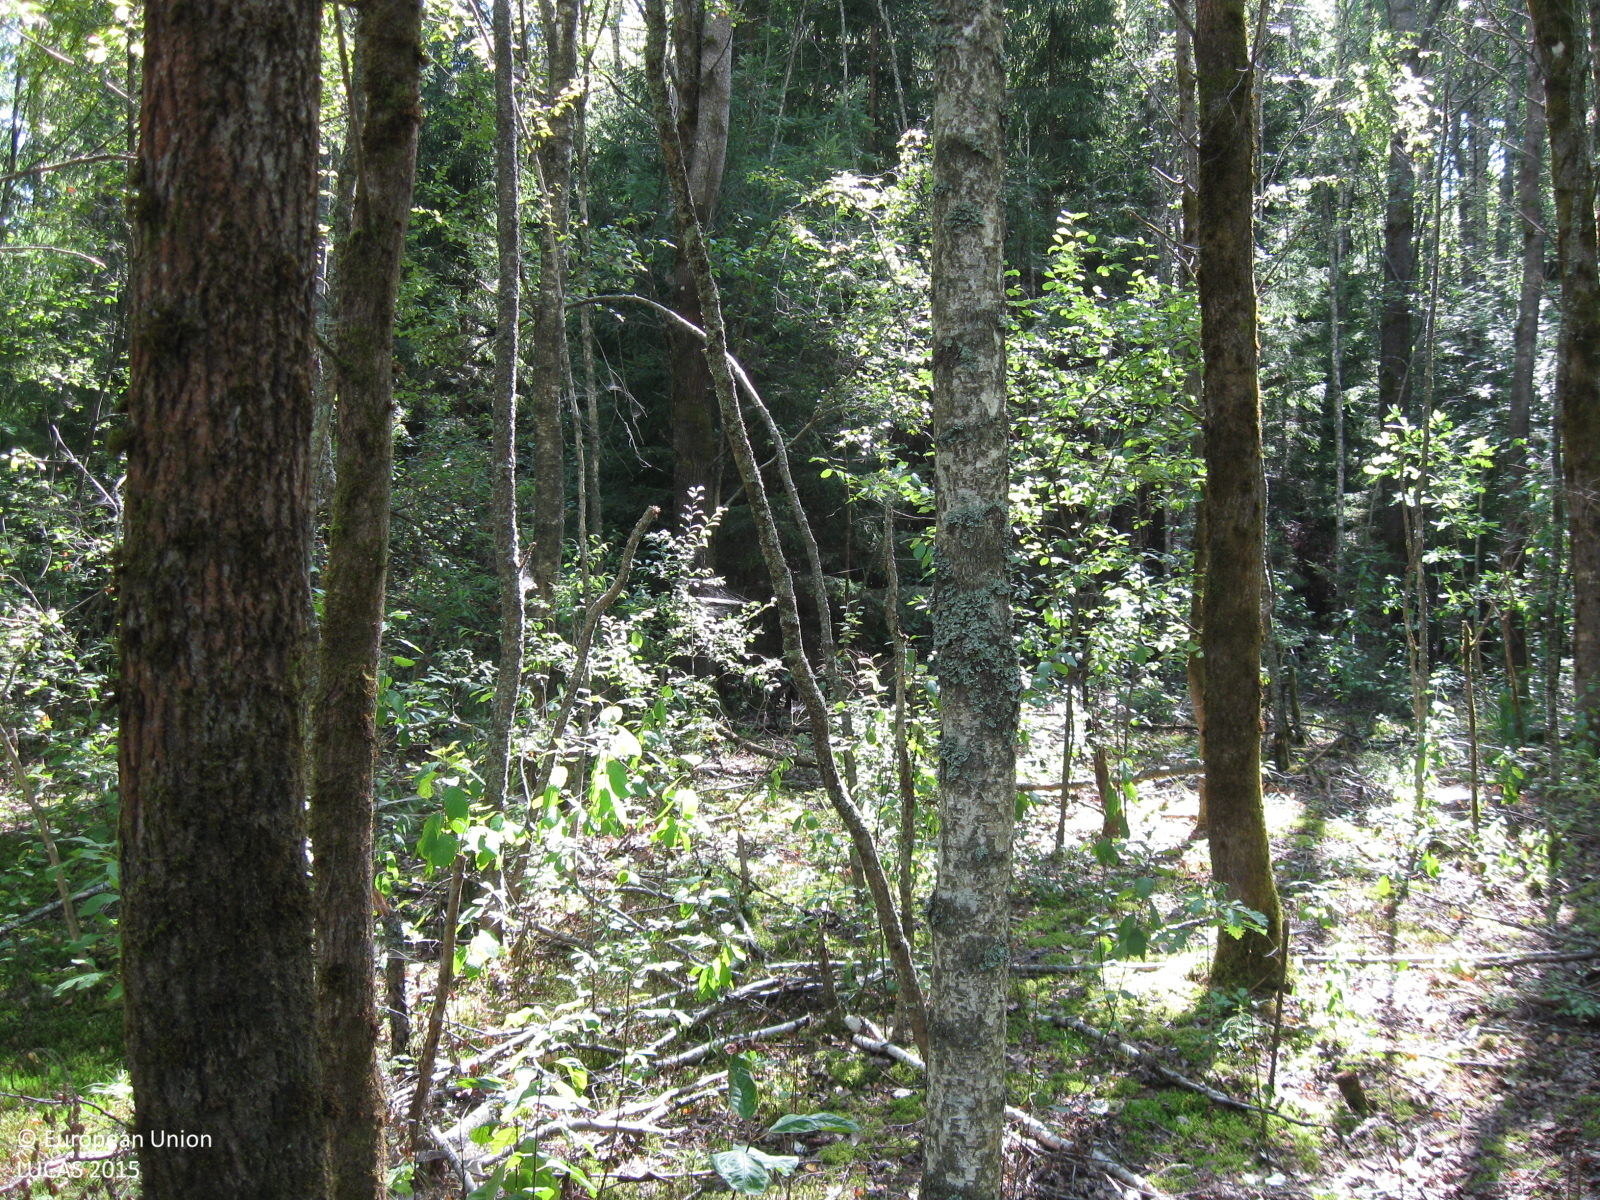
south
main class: Woodland
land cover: Other mixed woodland
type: hemiboreal forest and nemoral coniferous forest and mixed broadleaved-coniferous forest
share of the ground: > 75 %
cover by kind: broadleaved forest trees 65 %, coniferous forest trees 30 %, herbaceous plants 5 %
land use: Forestry
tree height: > 5 m
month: August
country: LT
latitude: 55.5838
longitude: 22.5791
